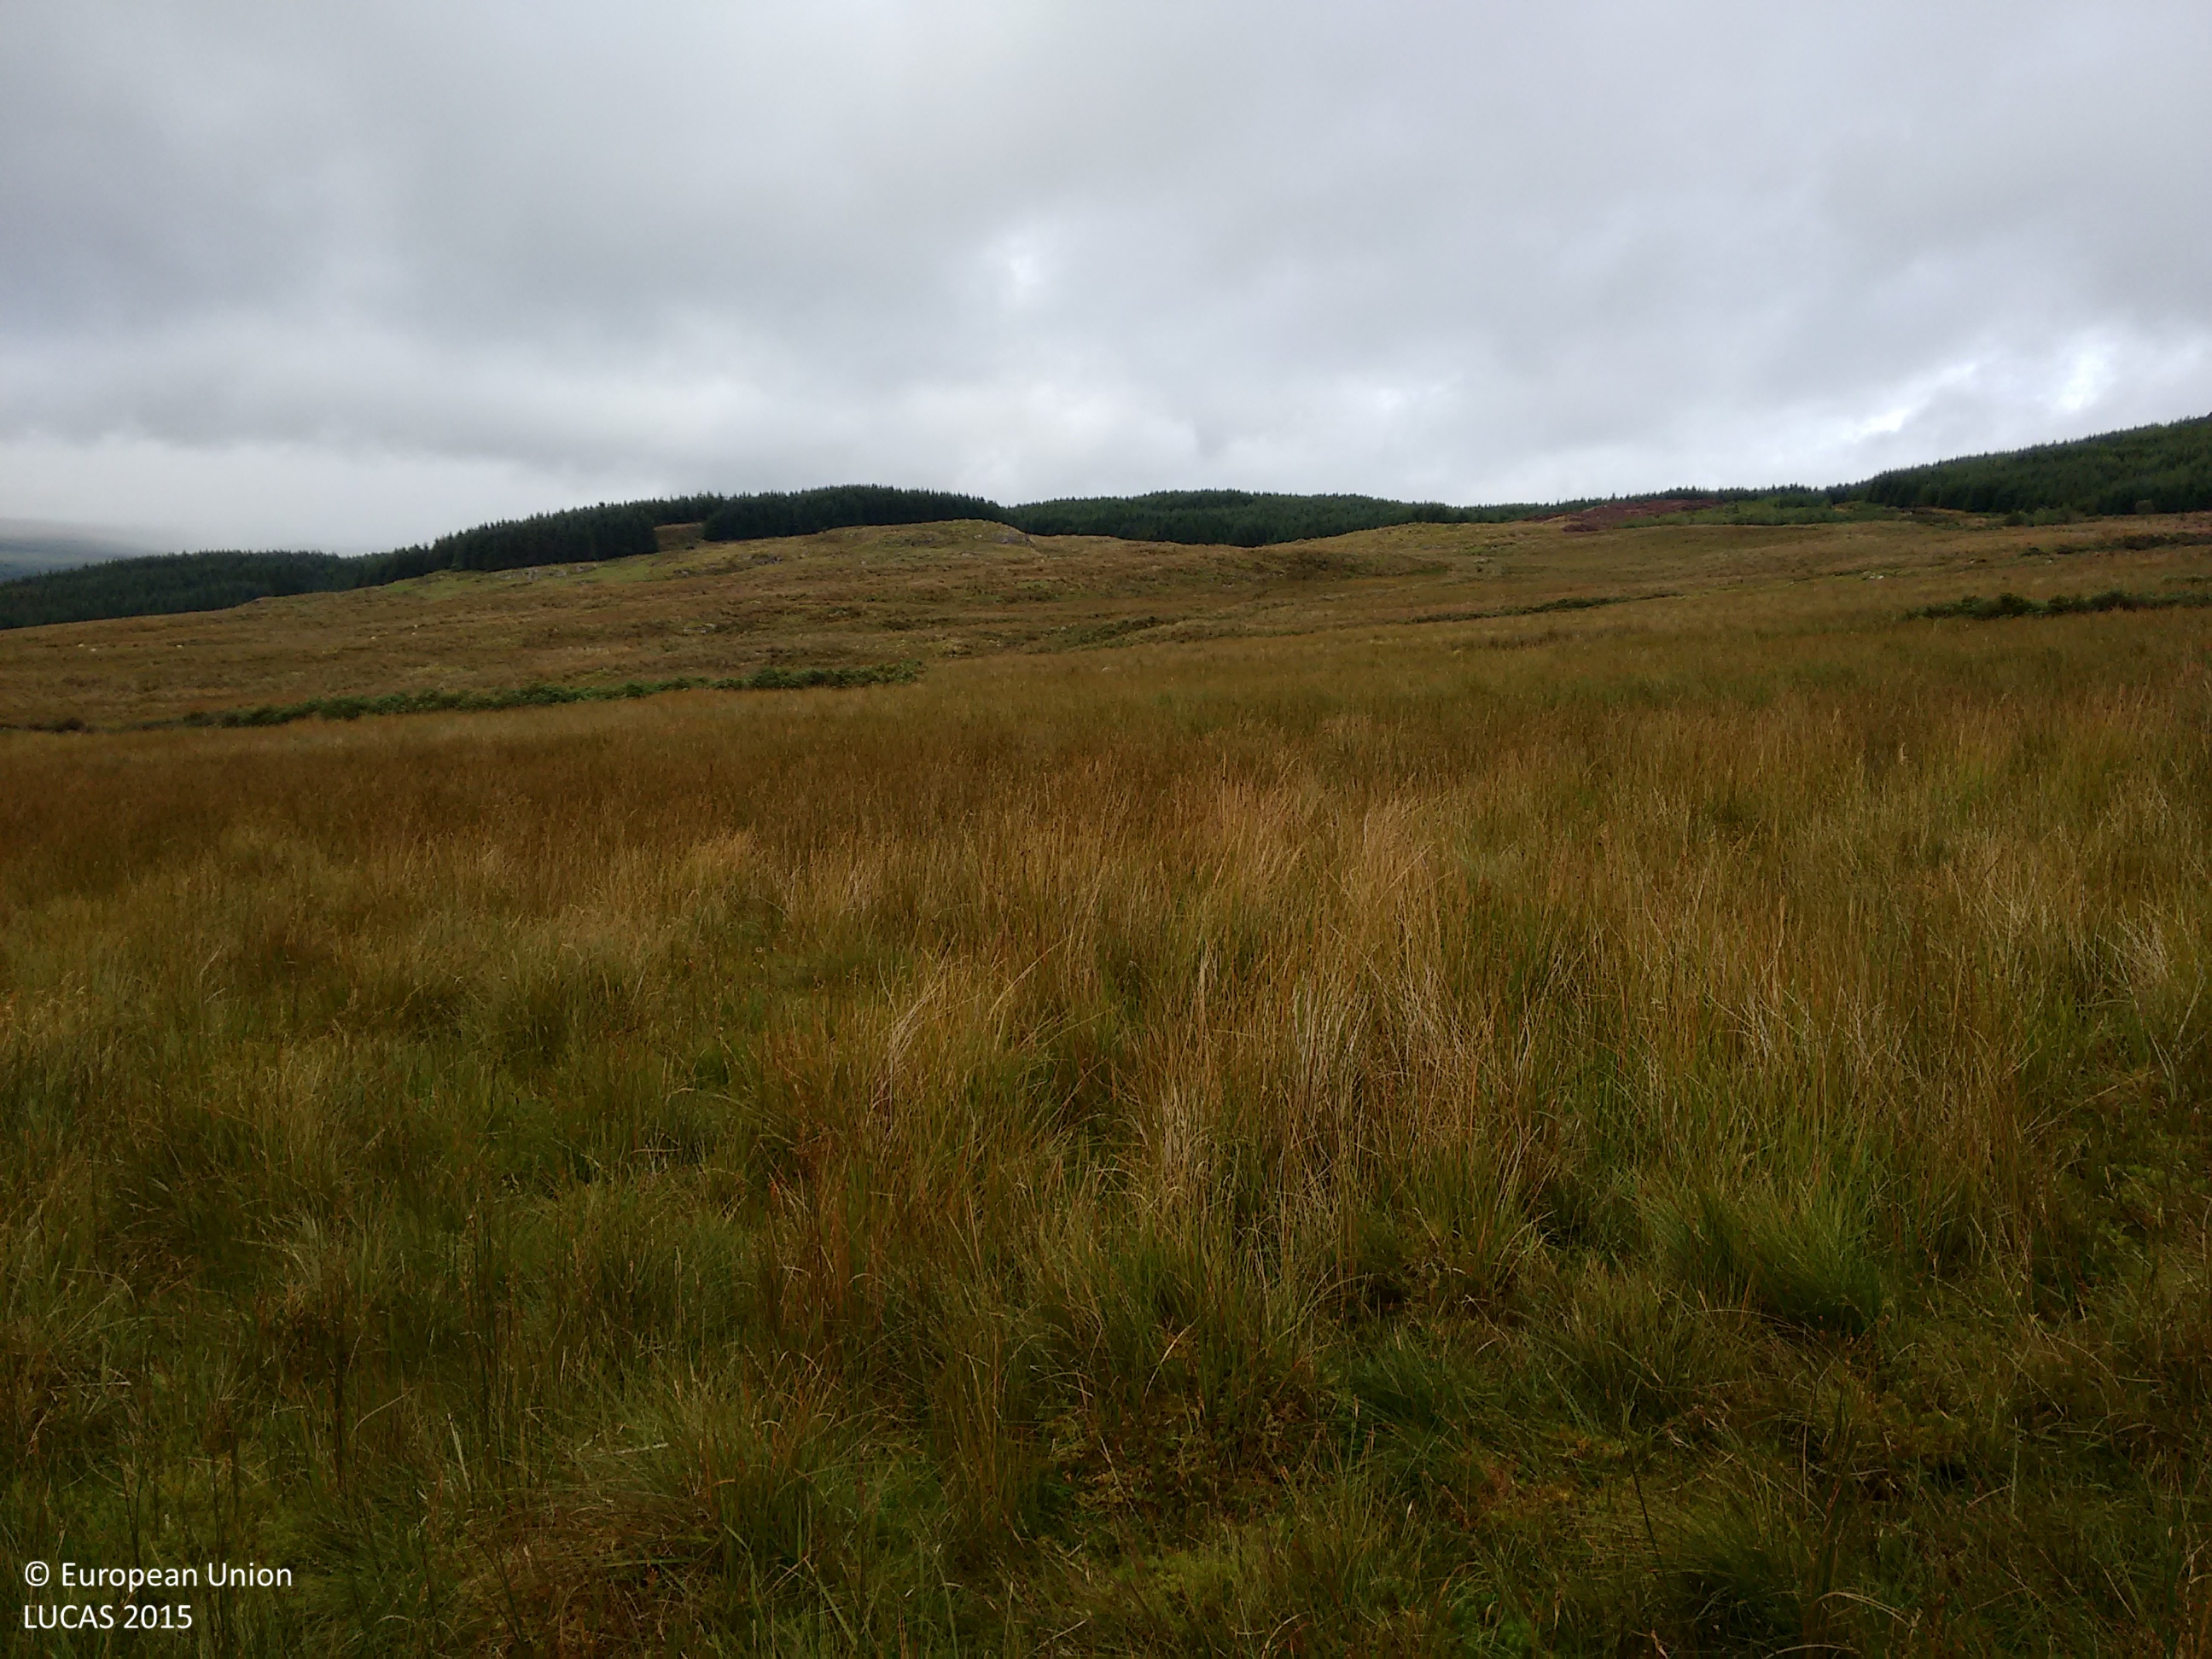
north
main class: Grassland
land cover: Grassland without tree/shrub cover
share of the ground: > 75 %
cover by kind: herbaceous plants 90 %, lichens and mosses 10 %
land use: Agriculture (excluding fallow land and kitchen gardens)
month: September
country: GB
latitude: 55.7941
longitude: -5.4498
